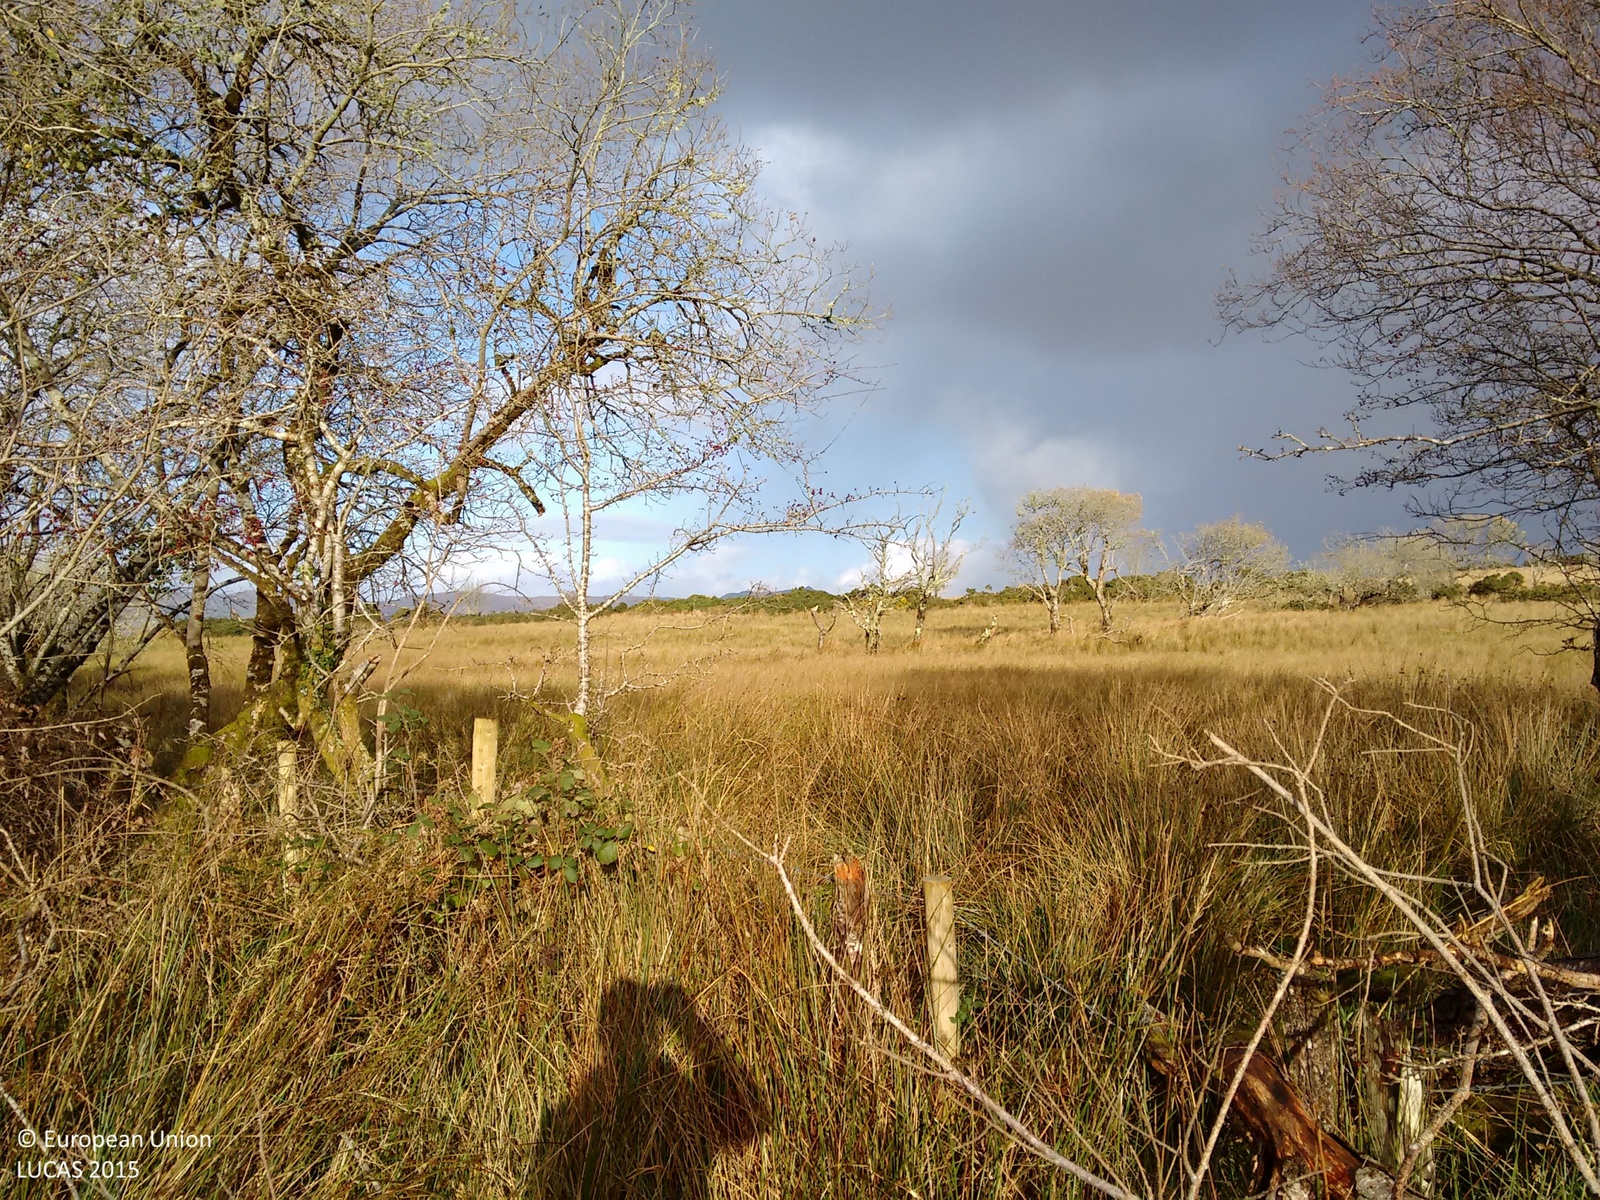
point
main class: Grassland
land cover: Grassland without tree/shrub cover
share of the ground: > 75 %
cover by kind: herbaceous plants 100 %
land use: Agriculture (excluding fallow land and kitchen gardens)
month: November
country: IE
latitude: 54.6681
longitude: -8.1804
